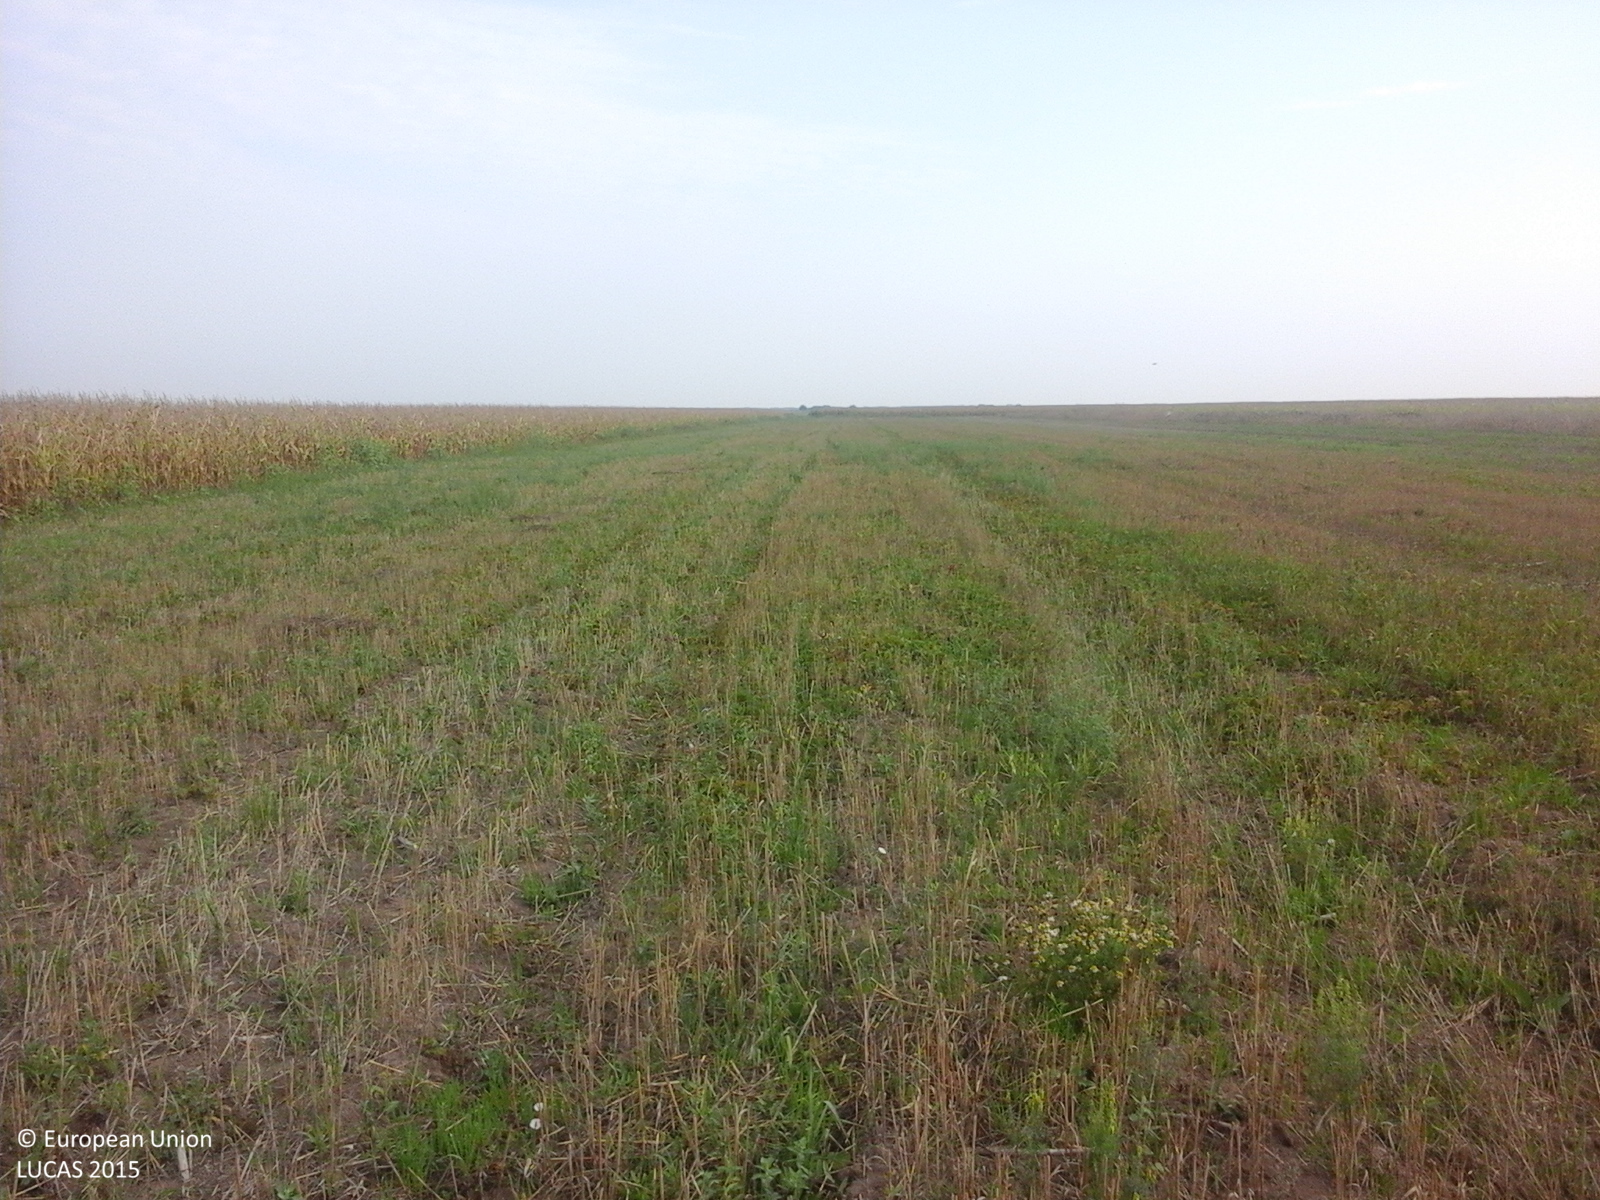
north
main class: Cropland
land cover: Oats
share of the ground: 25 - 50 %
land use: Agriculture (excluding fallow land and kitchen gardens)
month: August
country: RO
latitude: 46.3973
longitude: 21.7061
